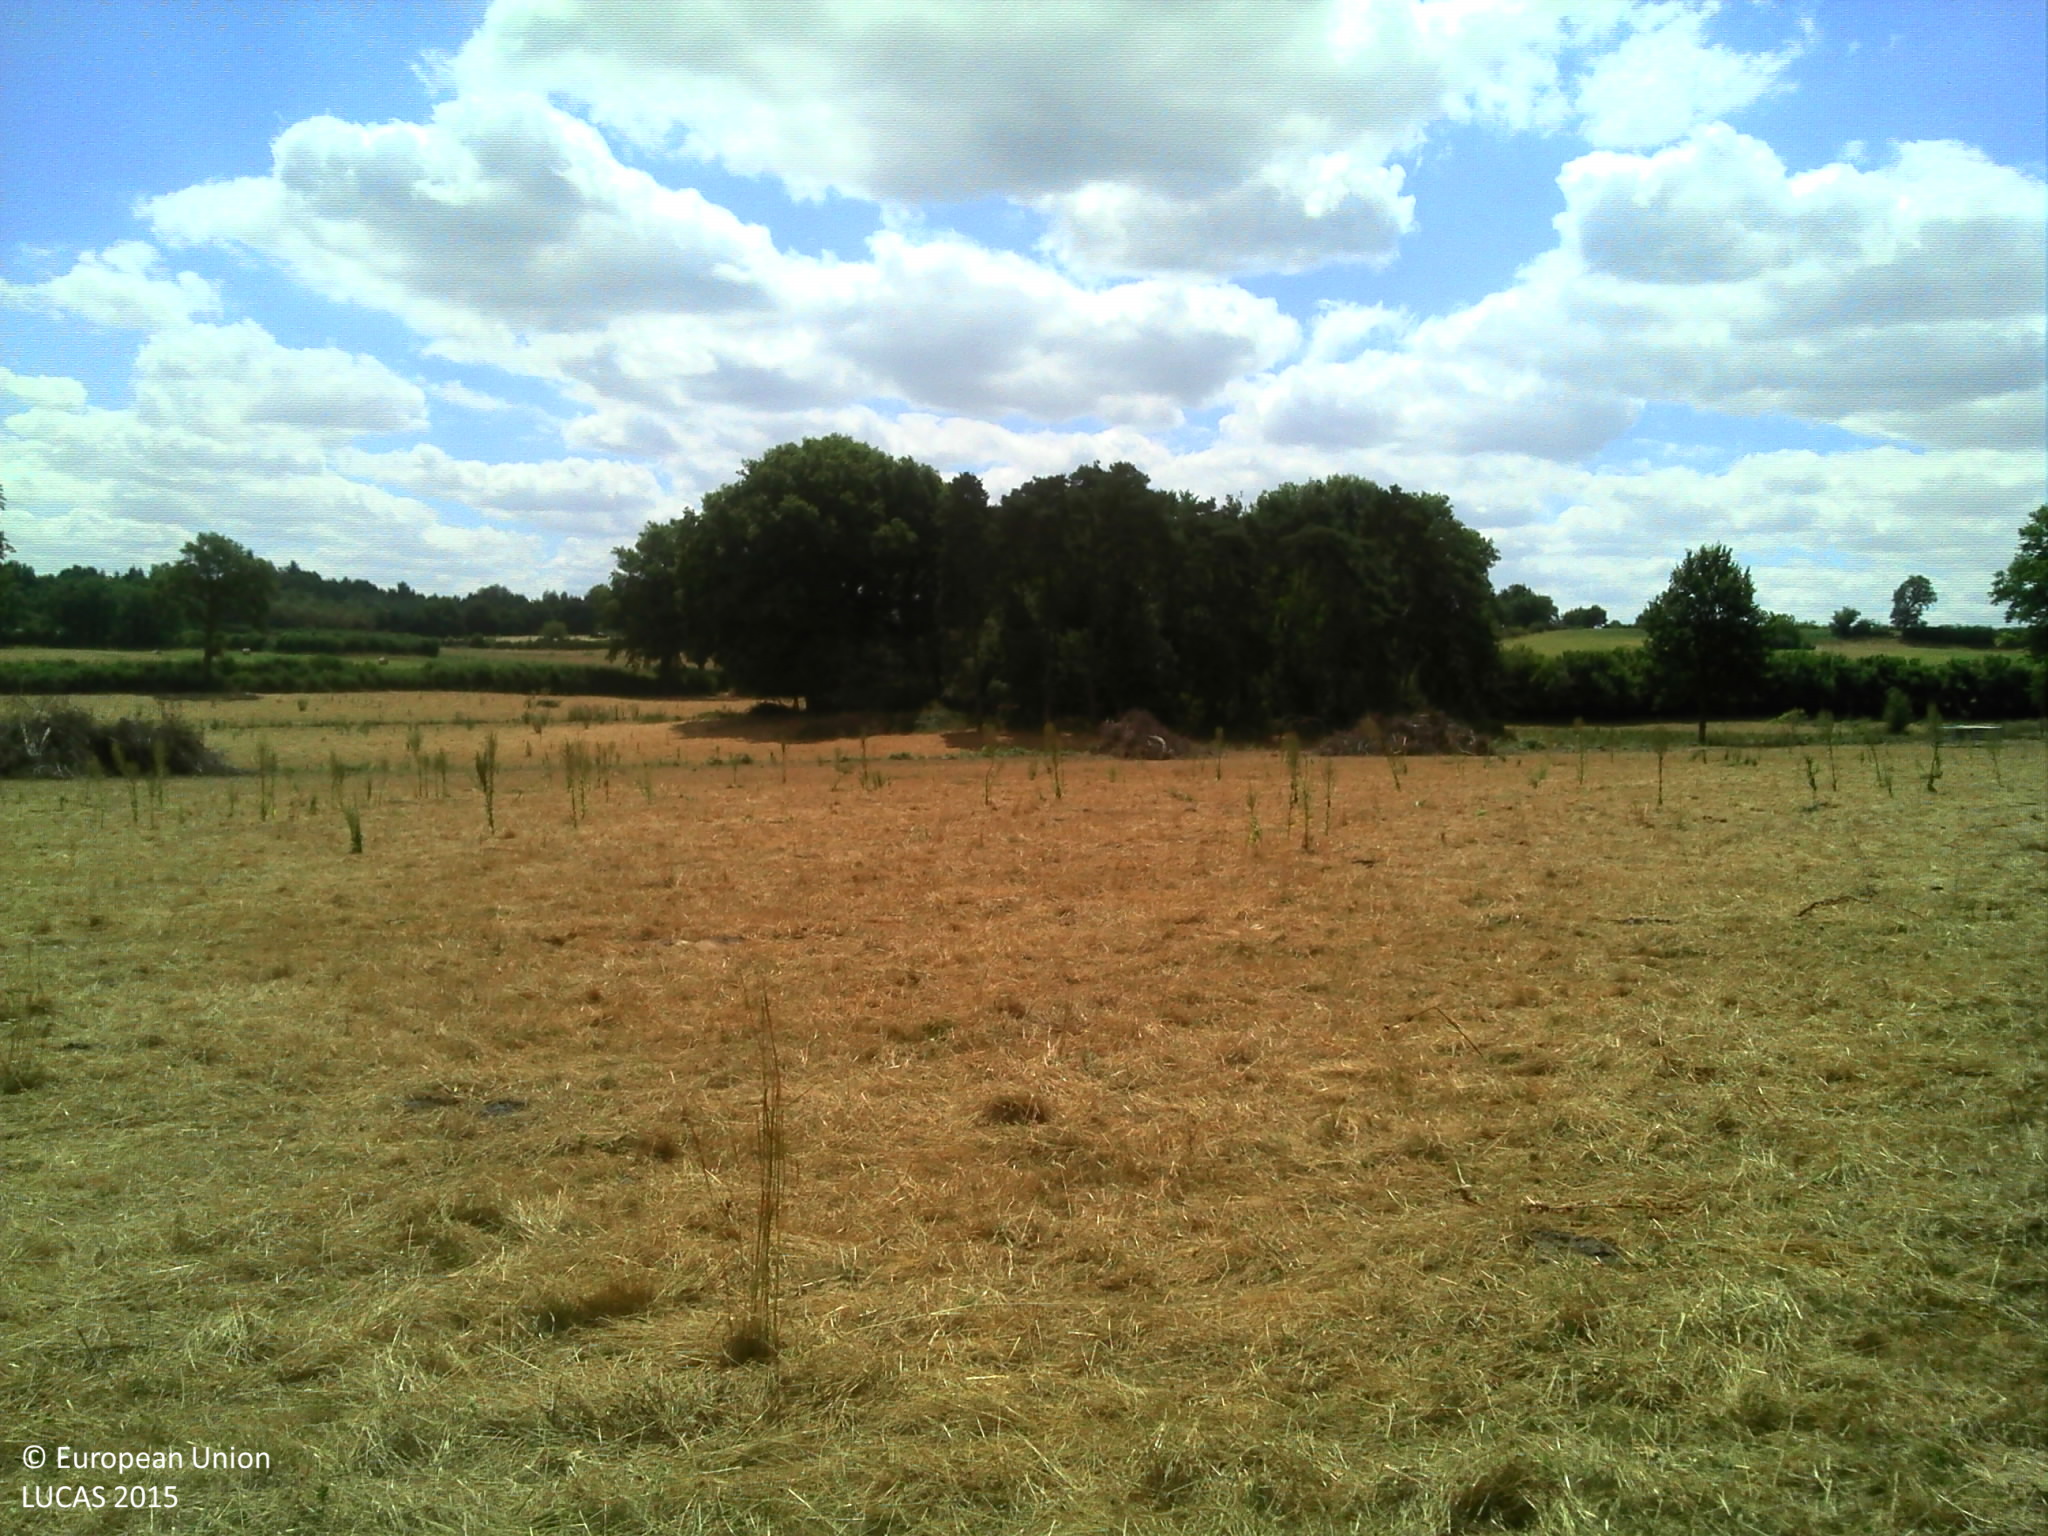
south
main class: Grassland
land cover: Grassland without tree/shrub cover
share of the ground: > 75 %
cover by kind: herbaceous plants 95 %, shrubs 5 %
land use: Agriculture (excluding fallow land and kitchen gardens)
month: July
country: FR
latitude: 46.4858
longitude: 2.7663
